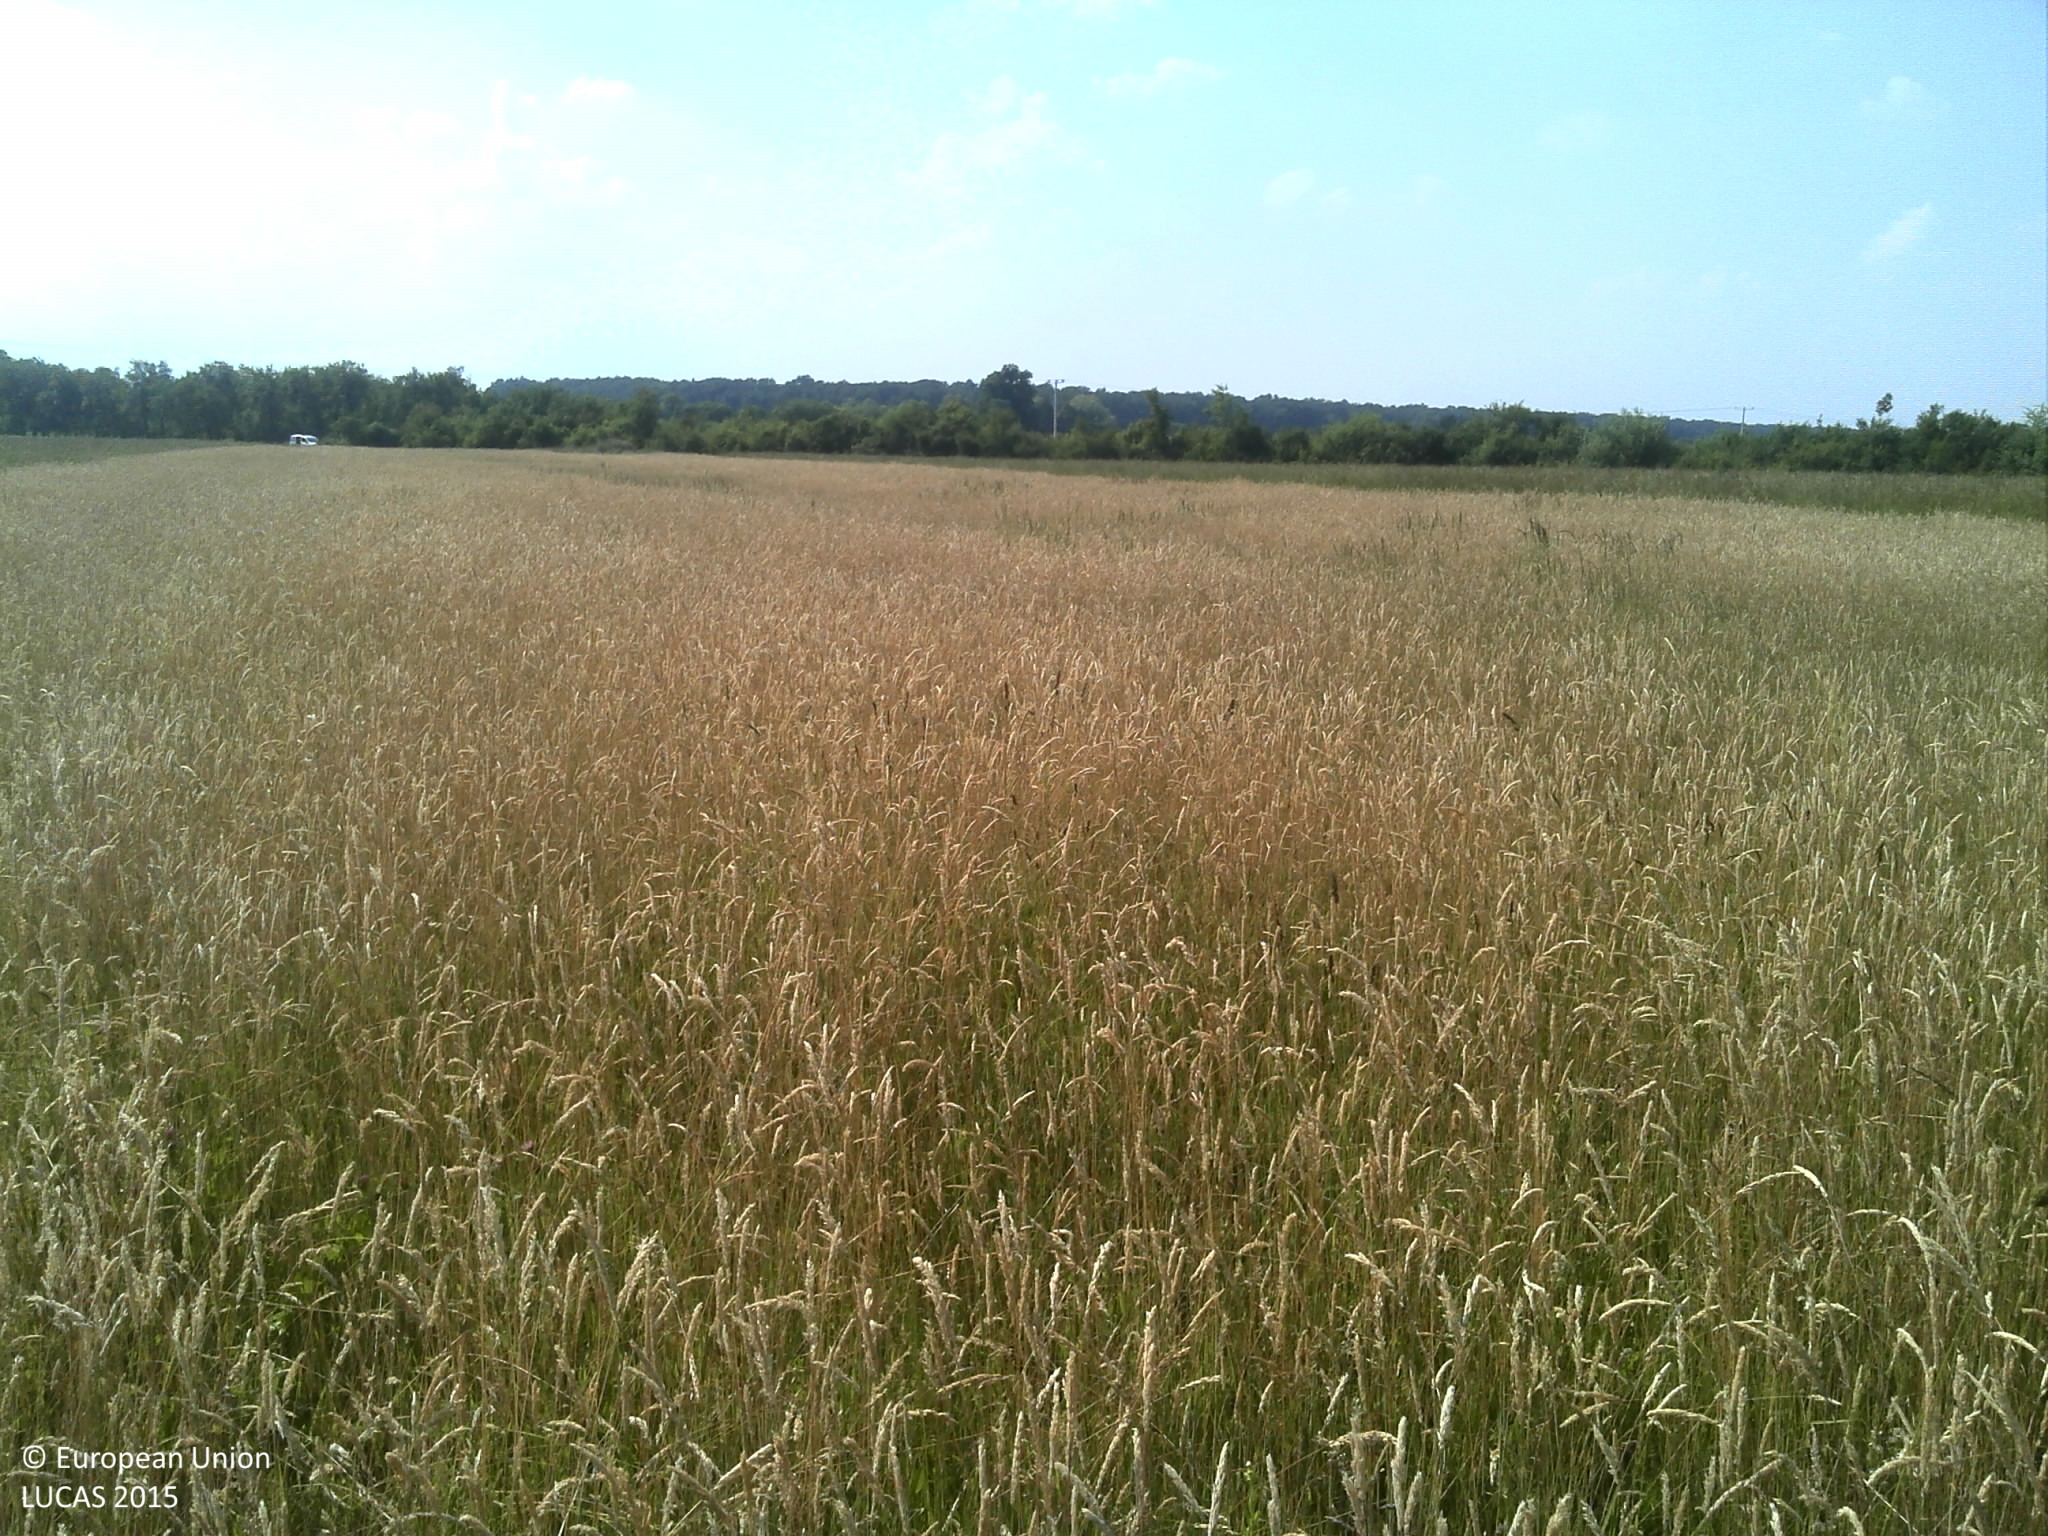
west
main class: Grassland
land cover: Spontaneously vegetated surfaces
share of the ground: > 75 %
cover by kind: herbaceous plants 100 %
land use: Fallow land
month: June
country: HR
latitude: 45.7004
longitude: 17.8511
